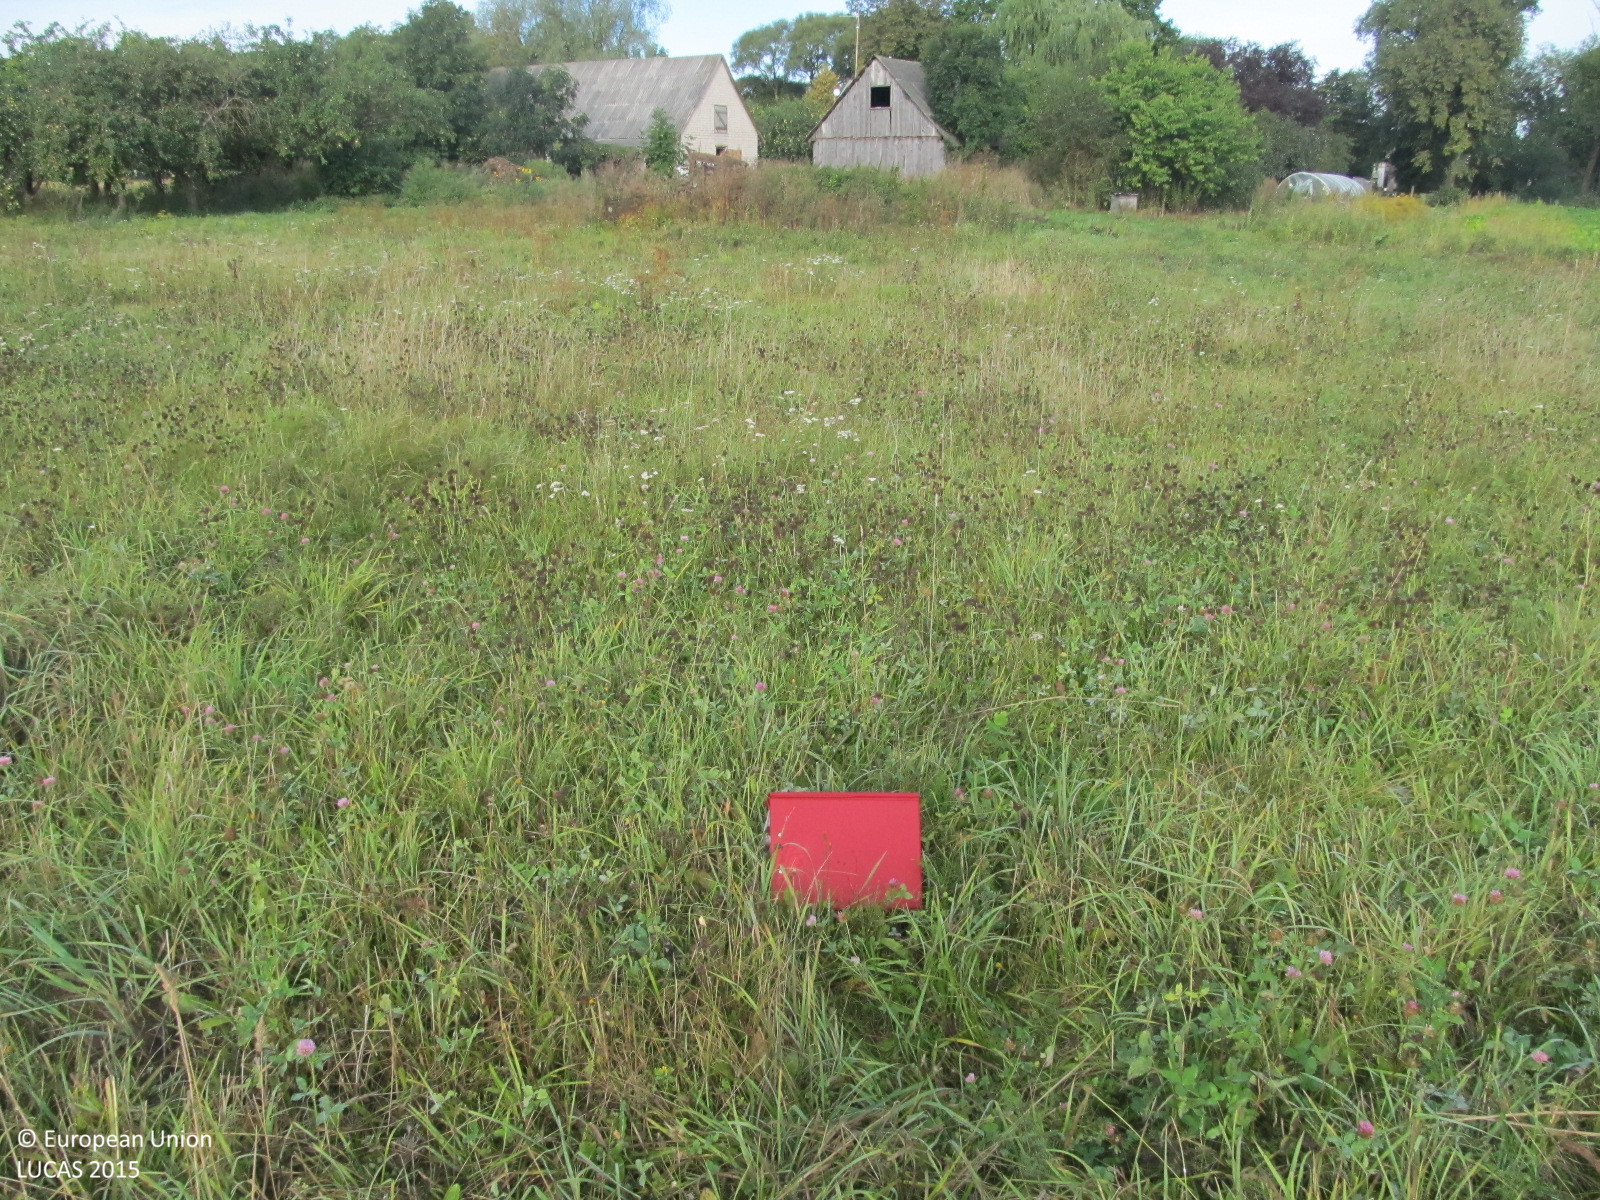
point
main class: Grassland
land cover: Grassland without tree/shrub cover
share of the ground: > 75 %
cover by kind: herbaceous plants 100 %
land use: Agriculture (excluding fallow land and kitchen gardens)
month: September
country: LT
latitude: 56.3115
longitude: 23.3116
